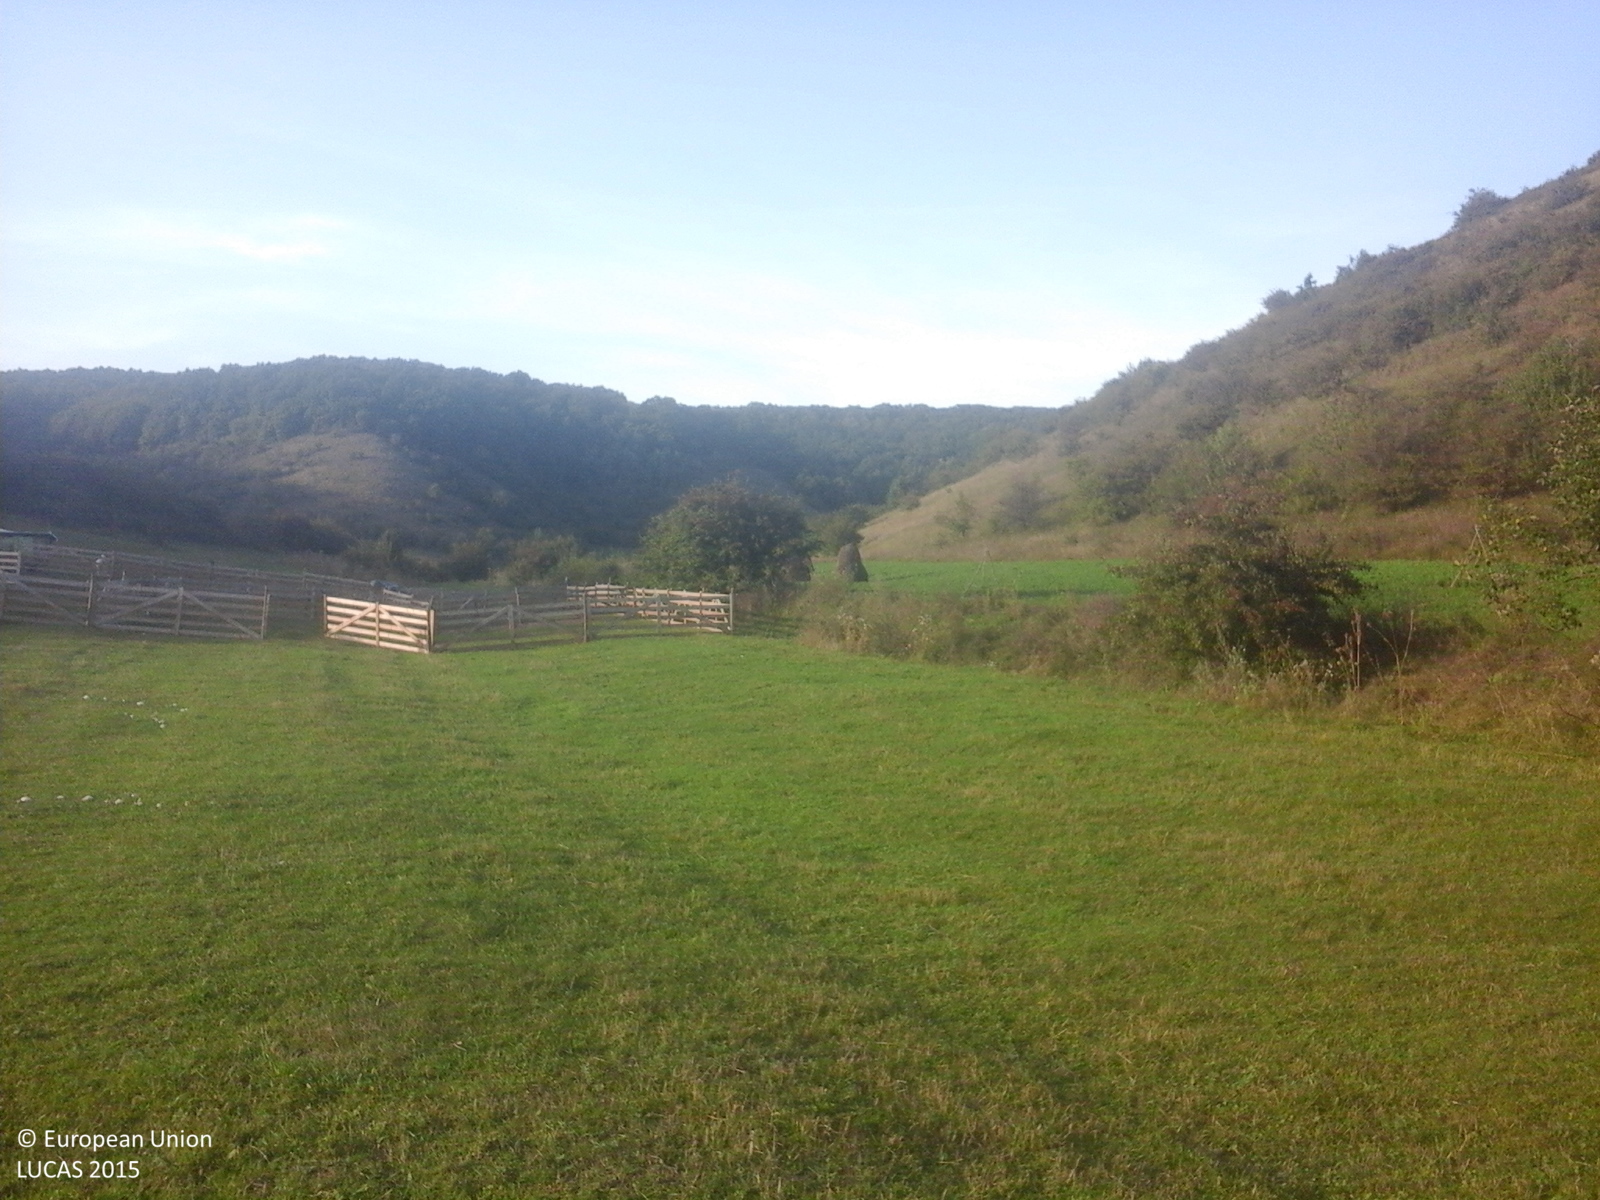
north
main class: Grassland
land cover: Grassland without tree/shrub cover
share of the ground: > 75 %
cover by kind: herbaceous plants 100 %
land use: Agriculture (excluding fallow land and kitchen gardens)
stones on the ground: < 10 %
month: September
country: RO
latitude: 46.7854
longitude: 23.3624
